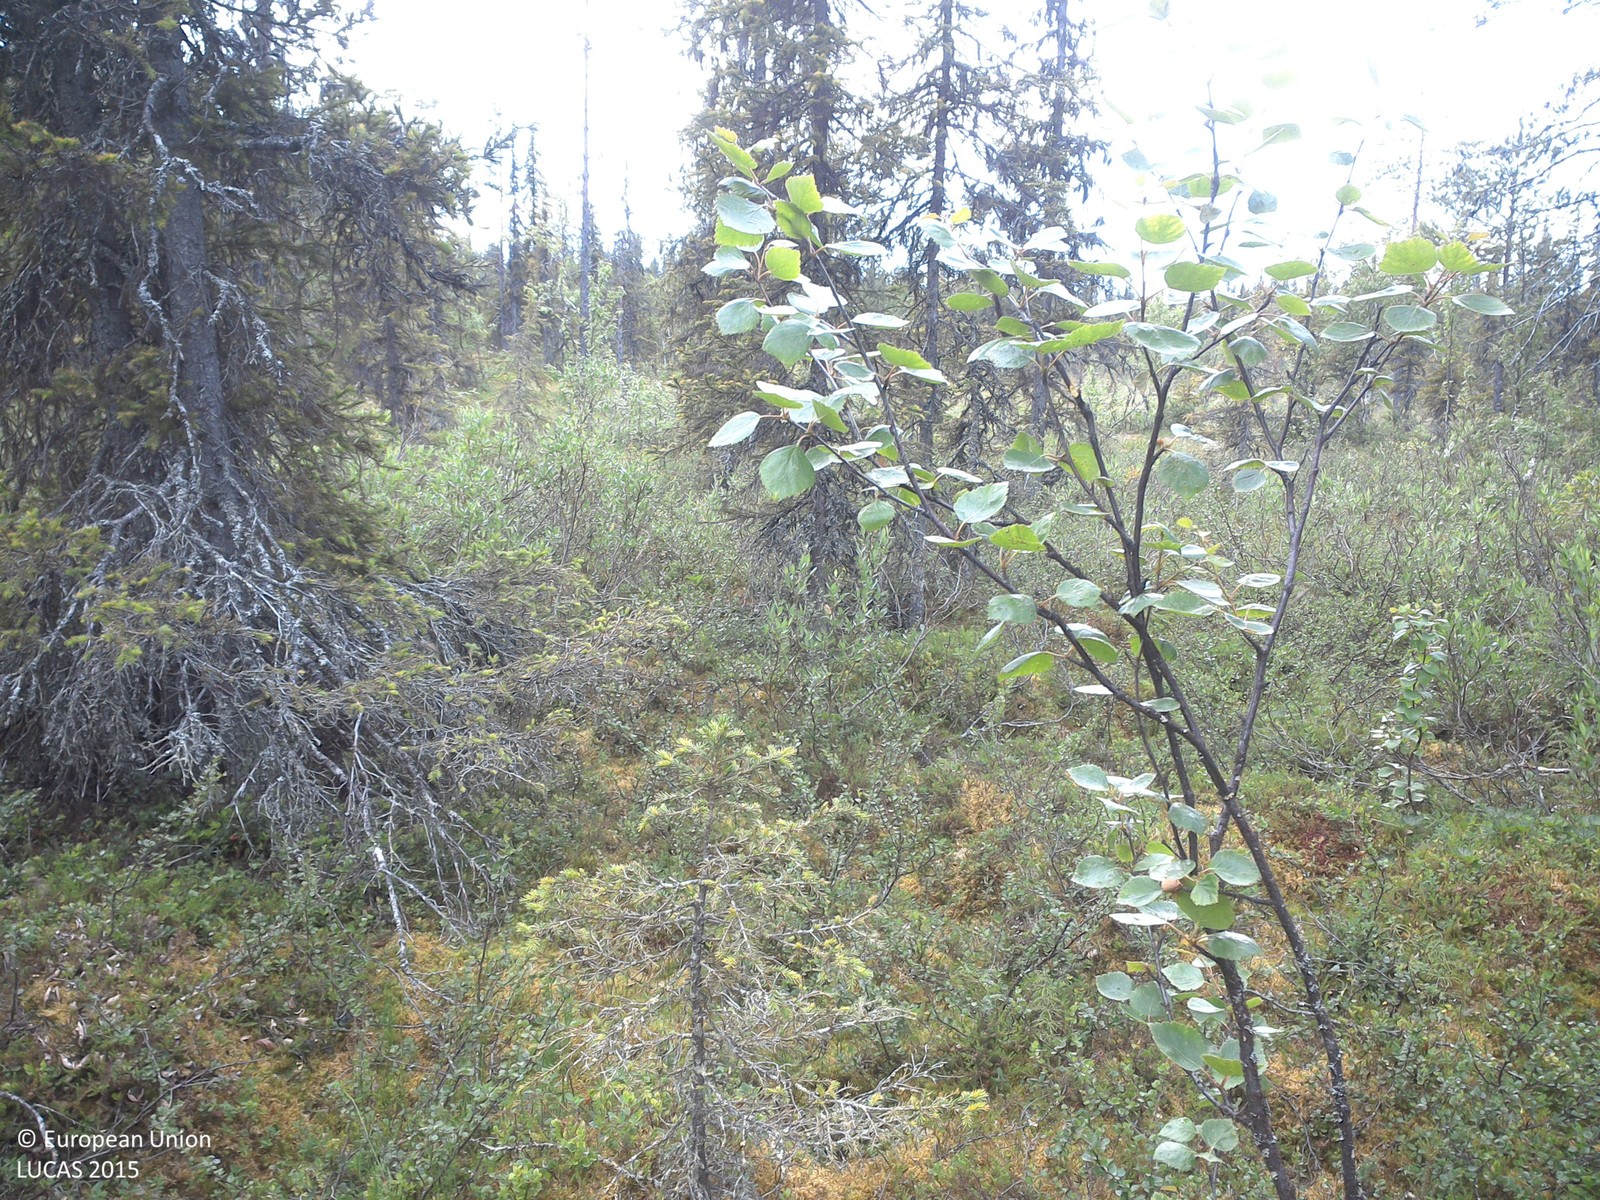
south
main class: Woodland
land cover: Spruce dominated mixed woodland
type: boreal forest
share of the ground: 10 - 25 %
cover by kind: shrubs 70 %, coniferous forest trees 15 %, lichens and mosses 10 %, broadleaved forest trees 5 %
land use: Forestry
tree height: > 5 m
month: July
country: SE
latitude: 67.4780
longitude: 22.0491
